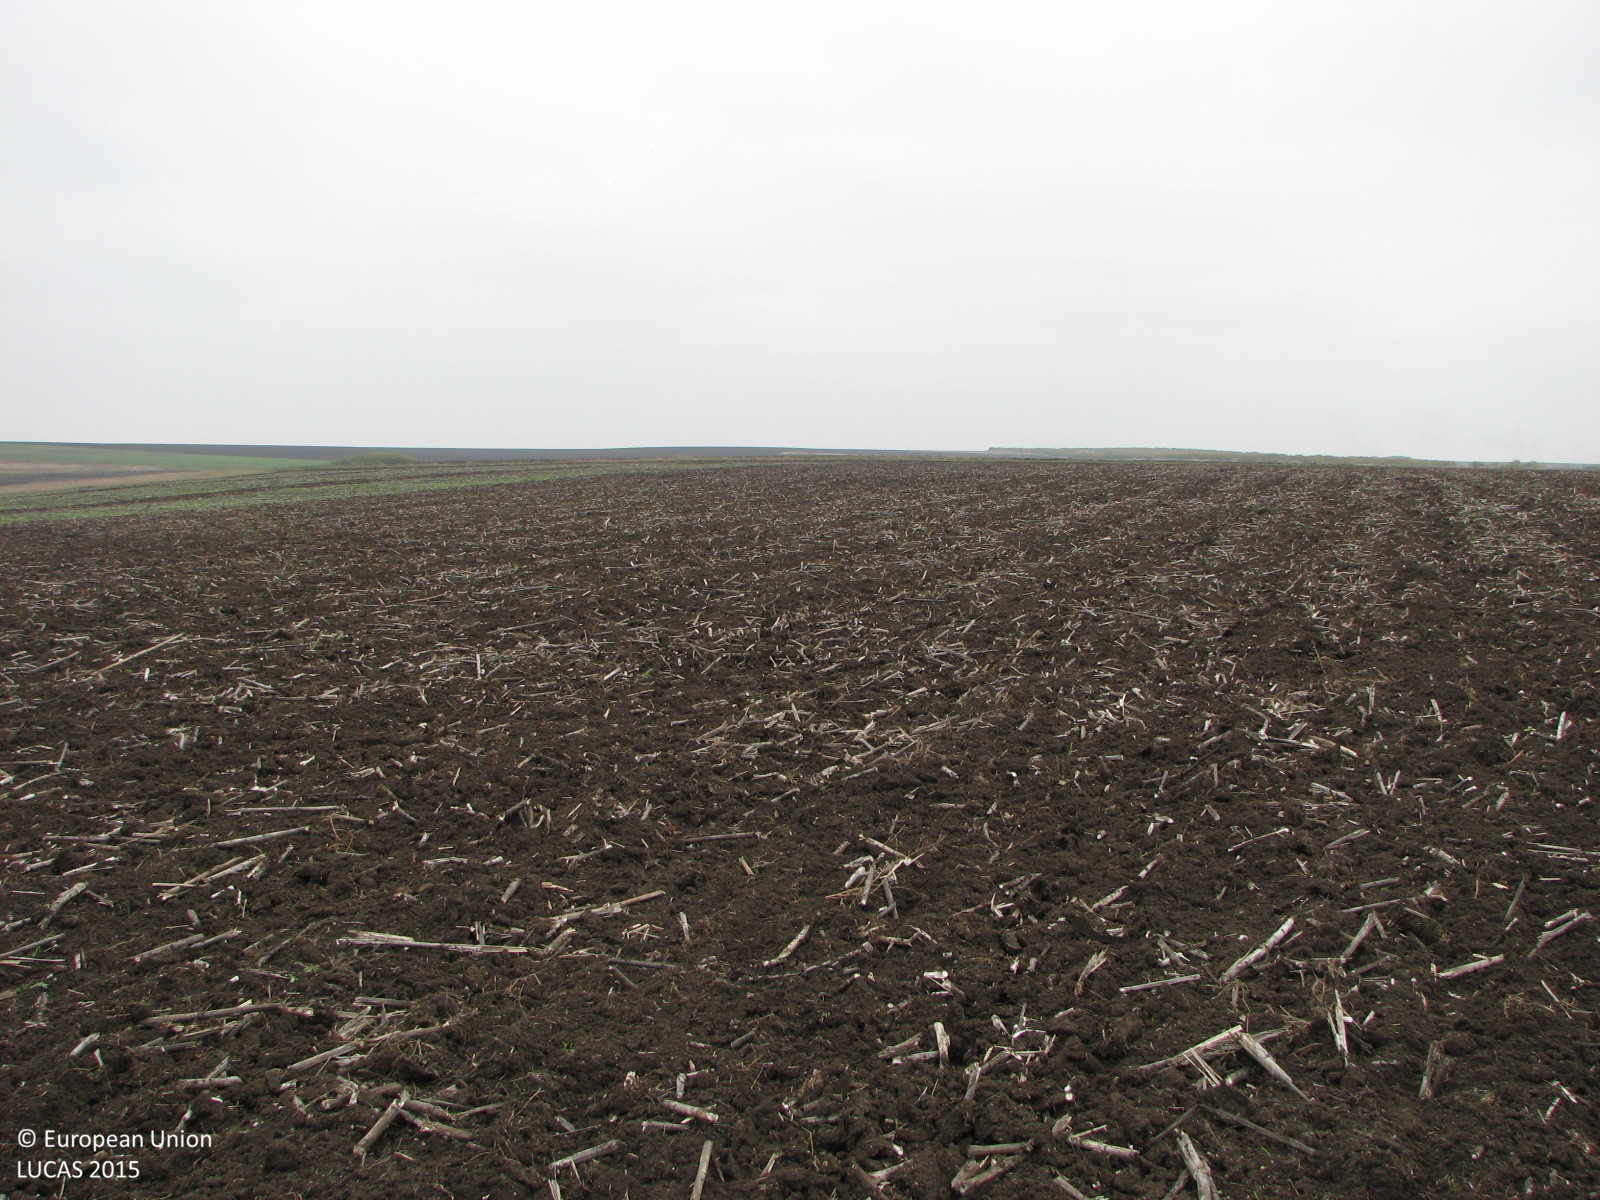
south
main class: Cropland
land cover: Rape and turnip rape
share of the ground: < 10 %
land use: Agriculture (excluding fallow land and kitchen gardens)
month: October
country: BG
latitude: 42.5465
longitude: 26.7955
